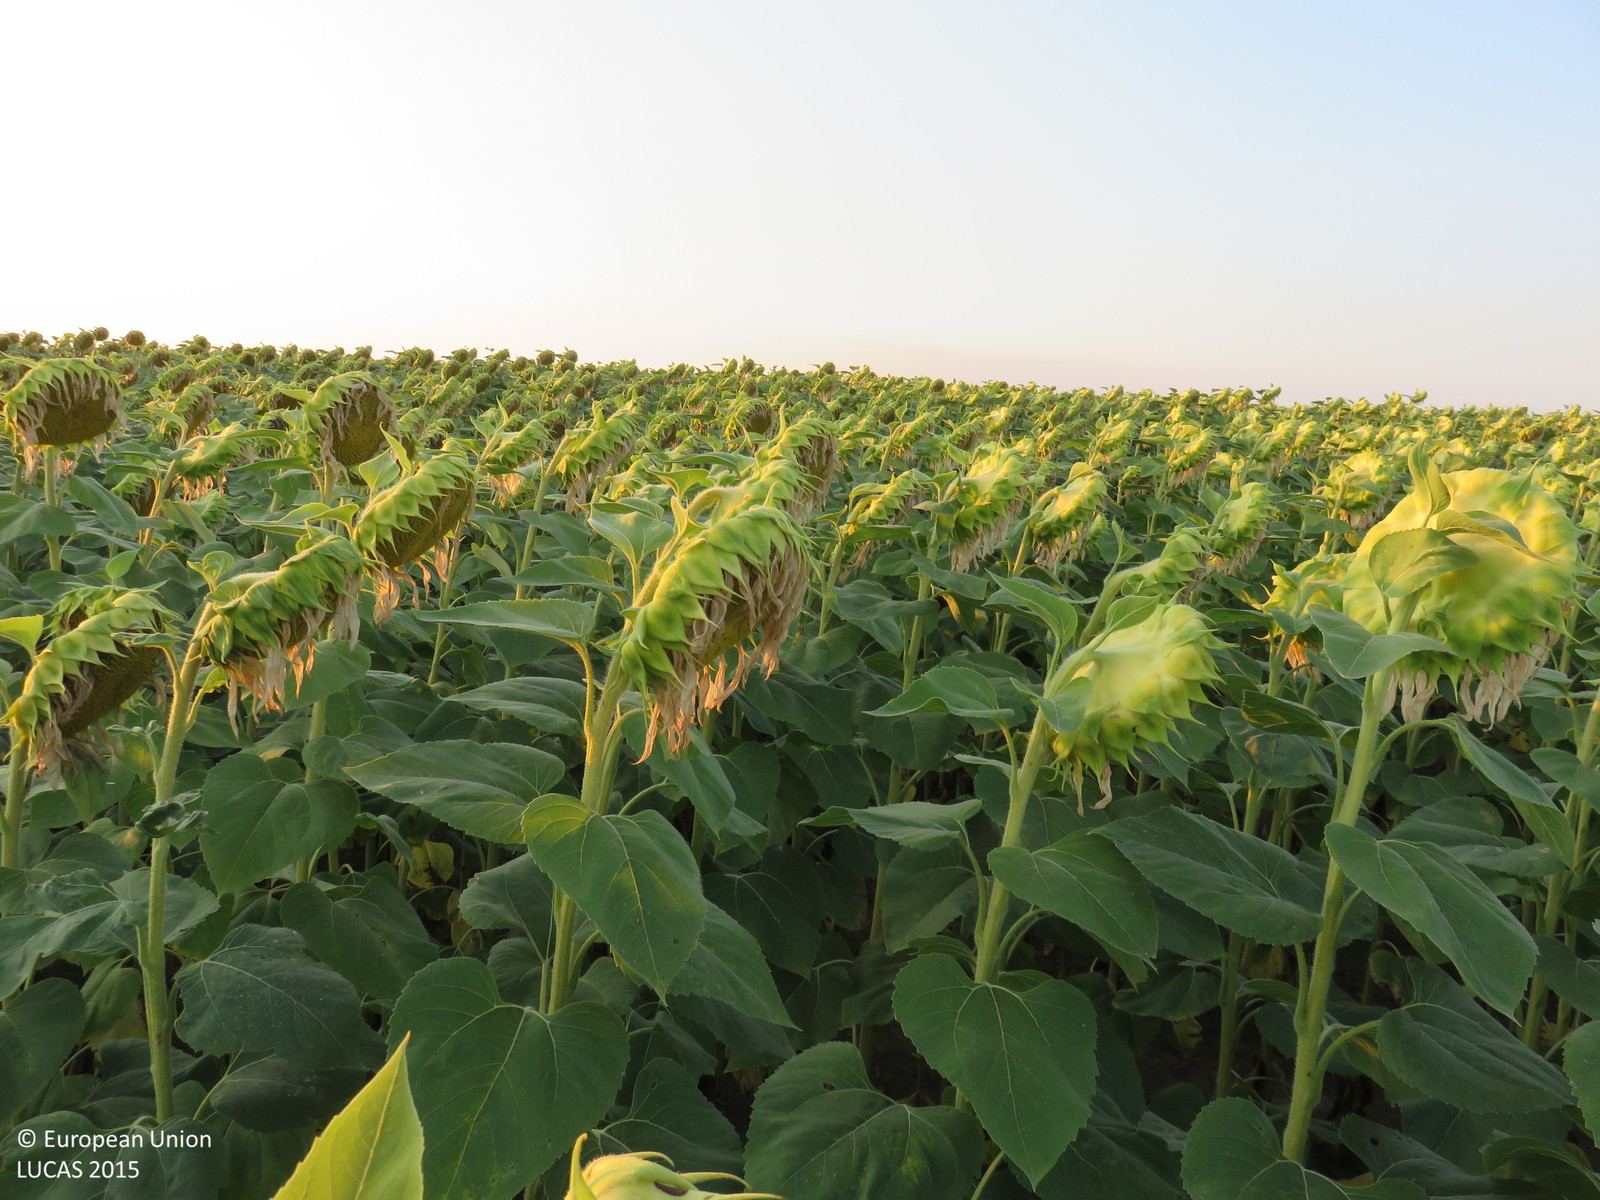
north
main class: Cropland
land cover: Sunflower
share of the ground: > 75 %
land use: Agriculture (excluding fallow land and kitchen gardens)
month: July
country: BG
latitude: 43.4808
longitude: 25.0694
